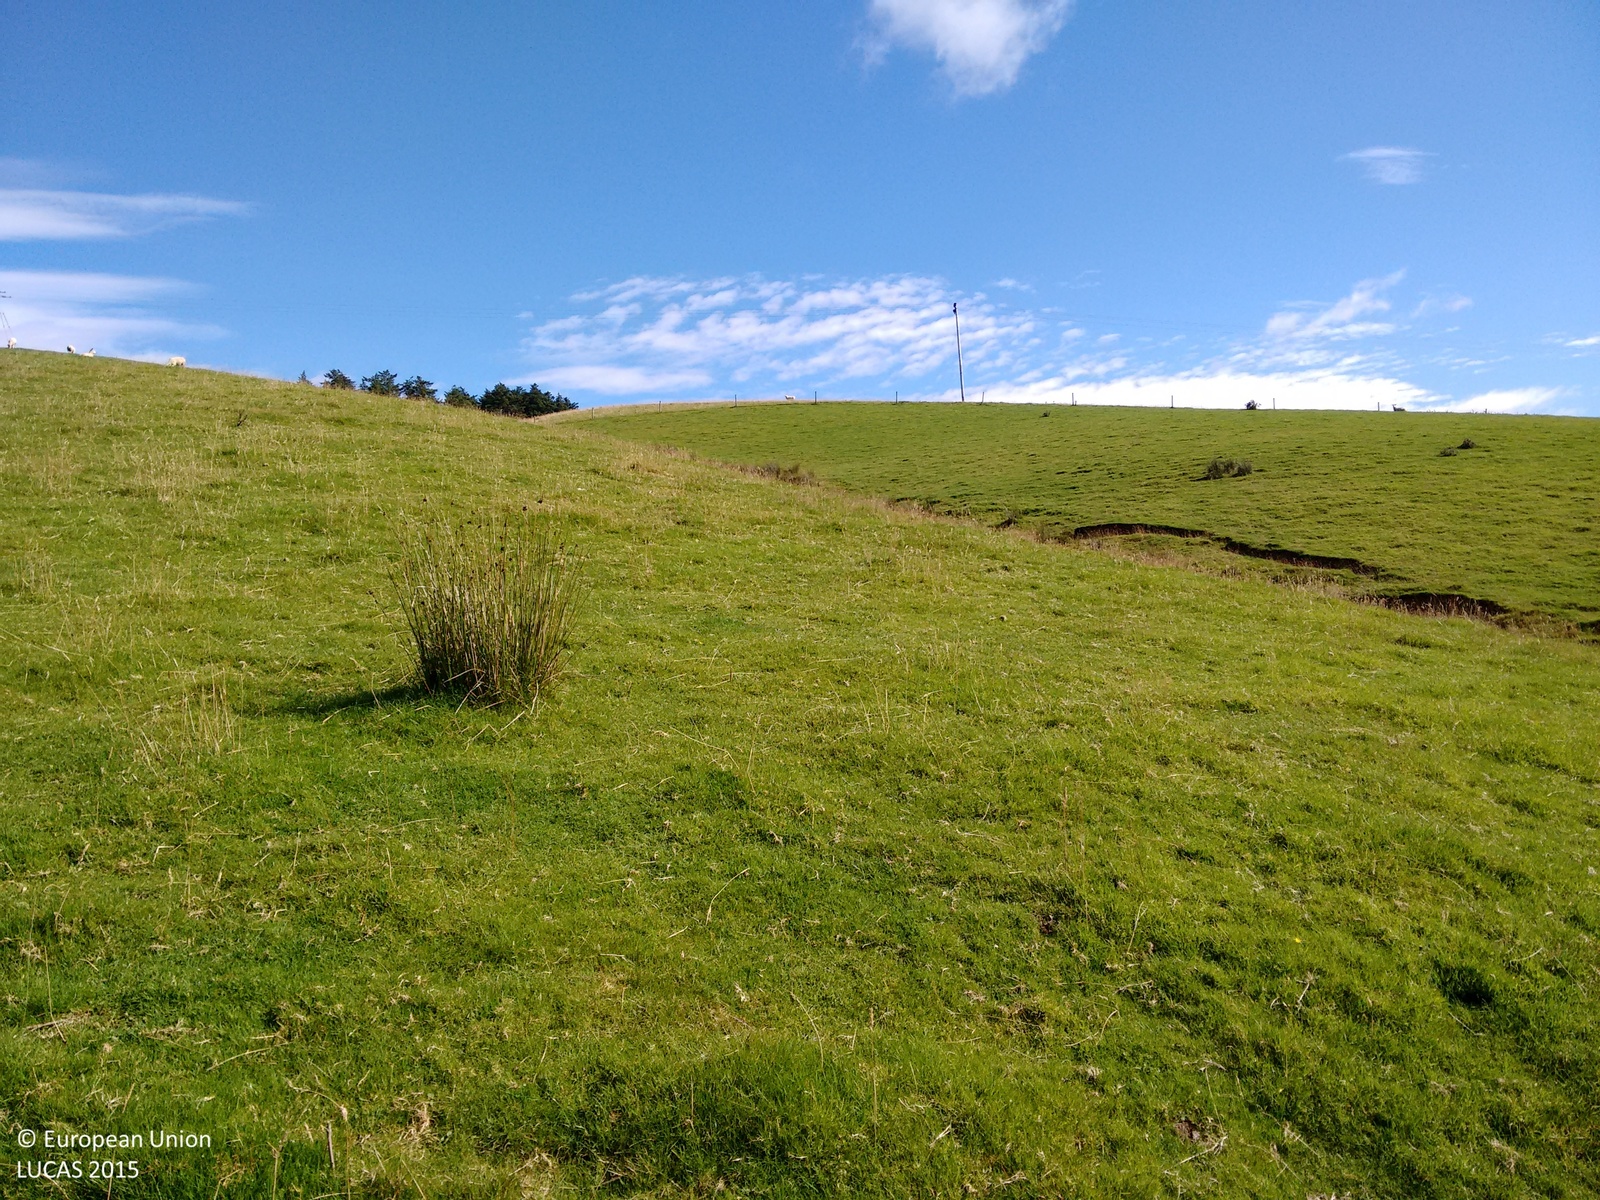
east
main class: Grassland
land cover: Grassland without tree/shrub cover
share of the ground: > 75 %
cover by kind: herbaceous plants 100 %
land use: Agriculture (excluding fallow land and kitchen gardens)
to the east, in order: Grassland without tree/shrub cover; Fences; Grassland without tree/shrub cover; Shrubland without tree cover; Fences; Shrubland without tree cover; Rivers and streams; Shrubland without tree cover
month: September
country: GB
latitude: 55.1562
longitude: -4.8139
